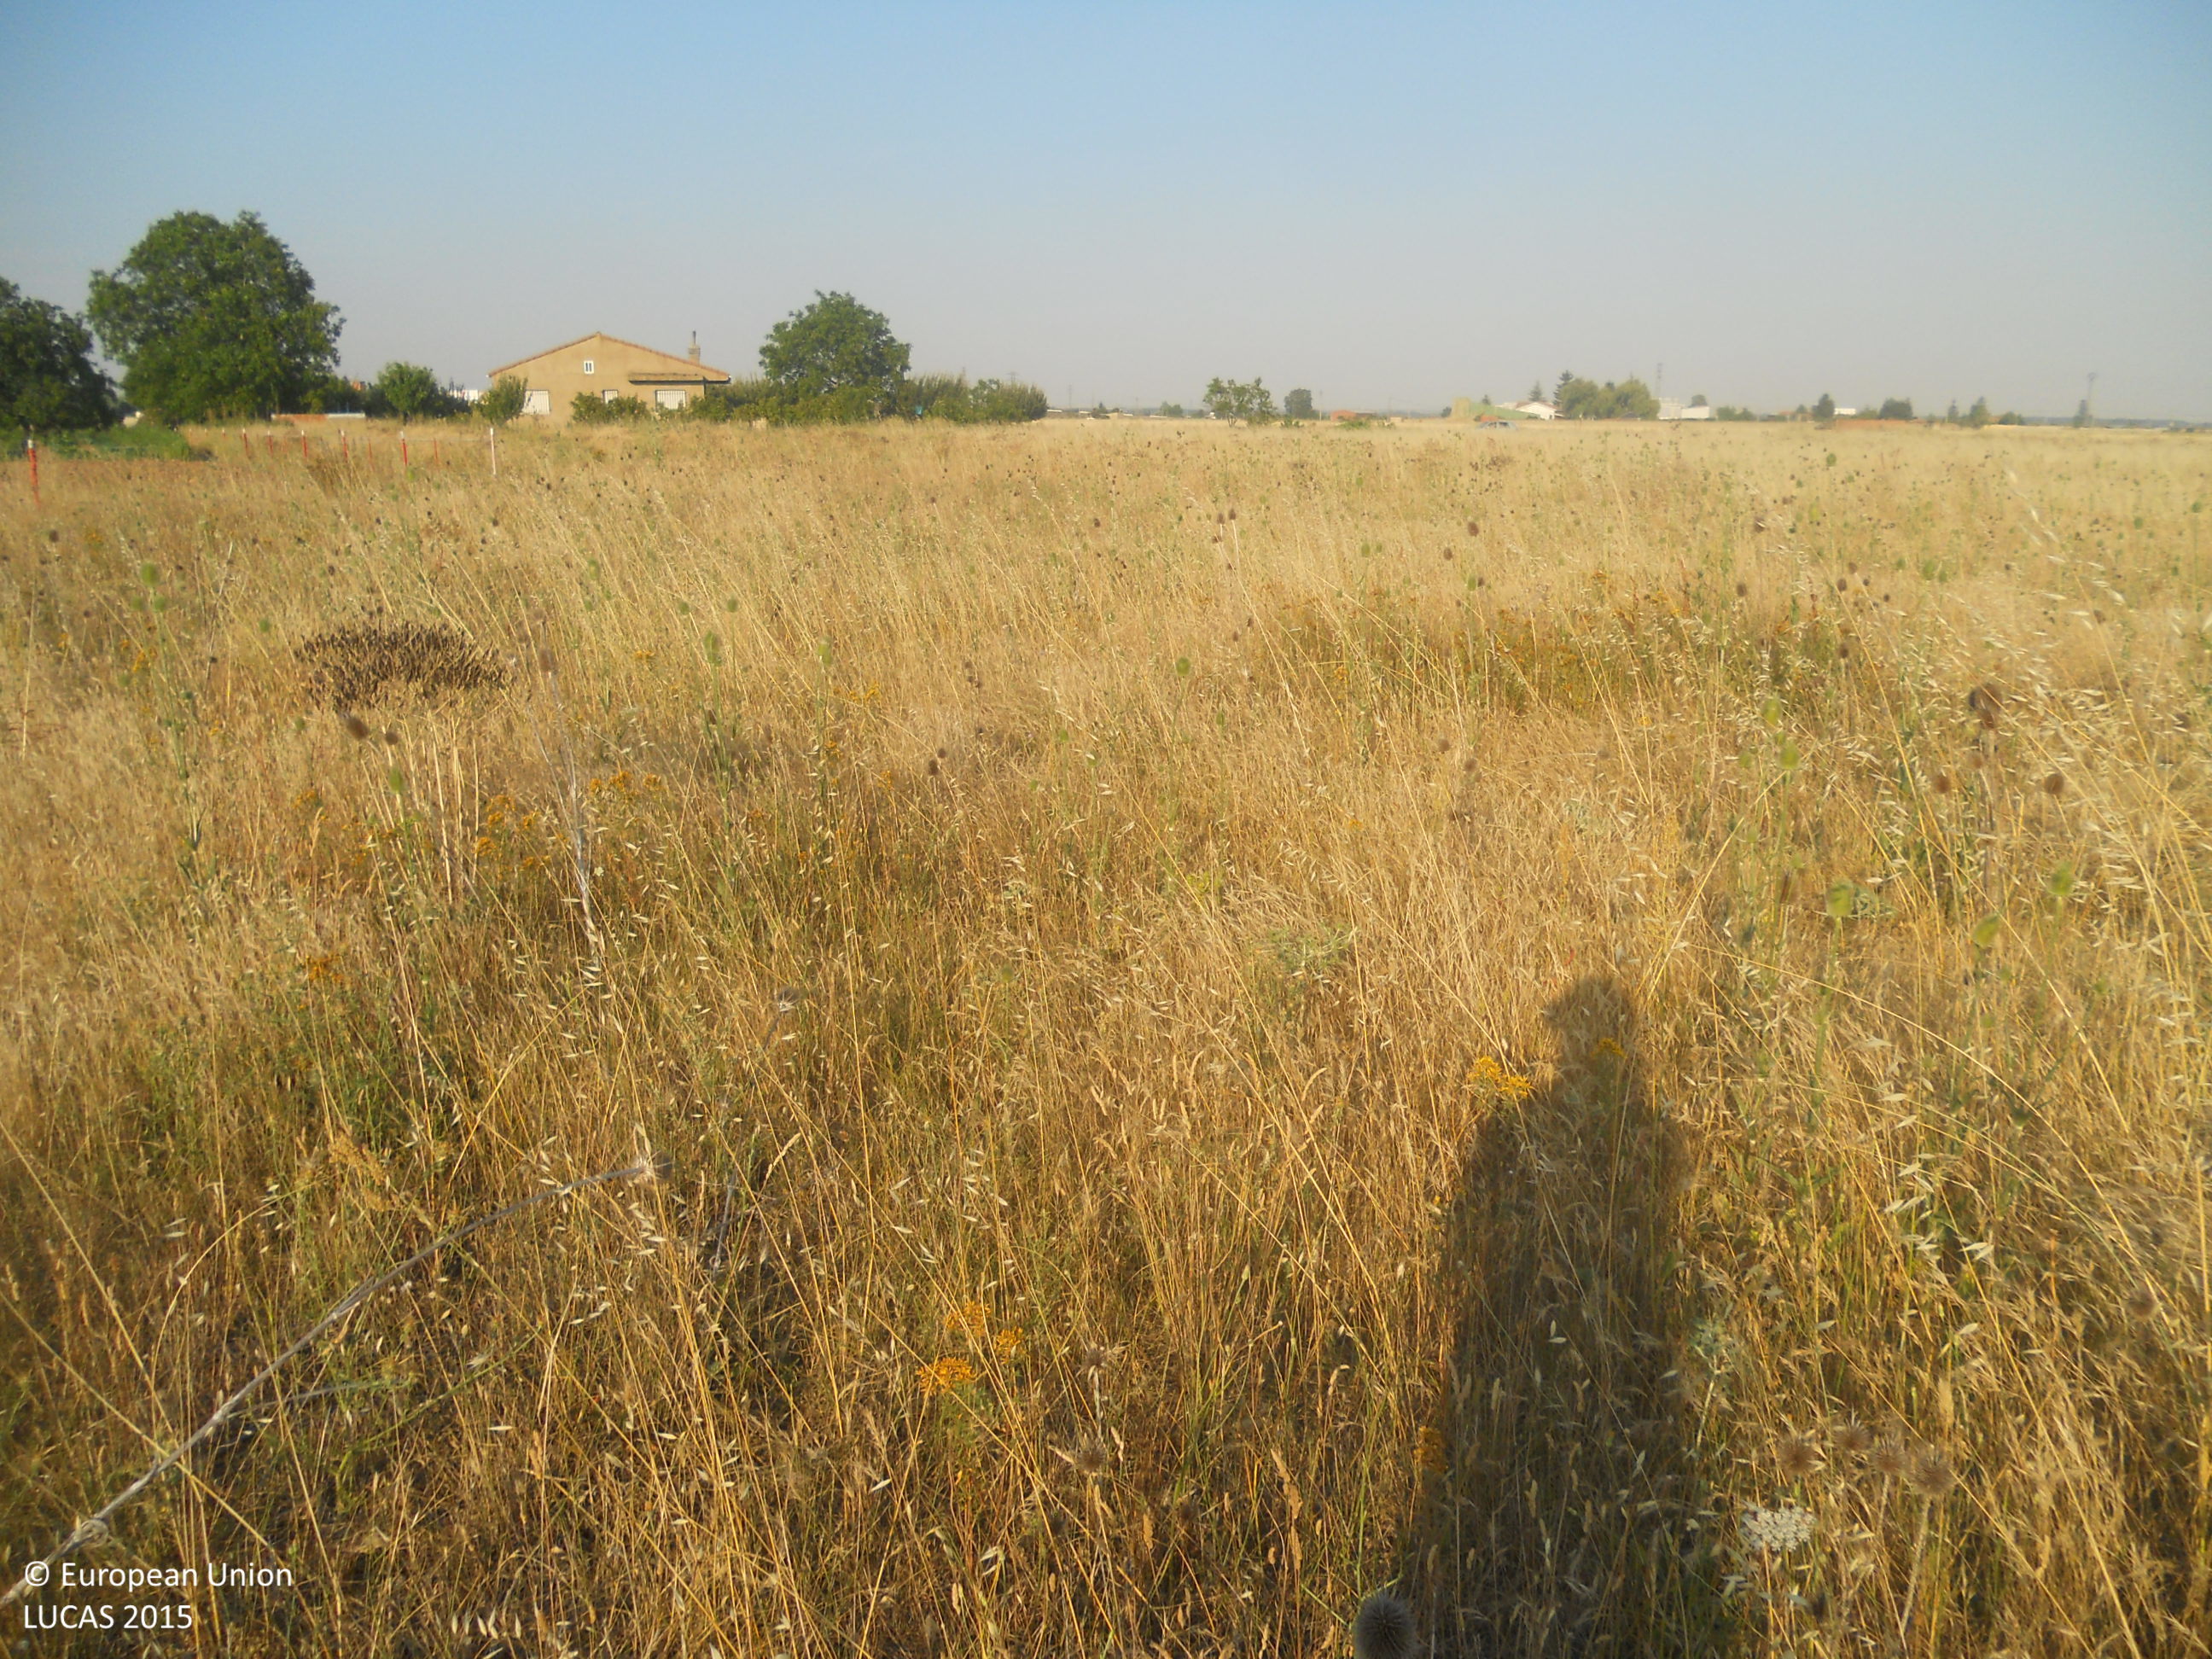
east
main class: Grassland
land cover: Grassland without tree/shrub cover
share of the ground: > 75 %
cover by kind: herbaceous plants 100 %
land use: Agriculture (excluding fallow land and kitchen gardens)
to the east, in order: Grassland without tree/shrub cover; Other bare soil; Grass margins; Tracks; Grass margins; Common wheat
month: July
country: ES
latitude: 42.5209
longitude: -5.5923
